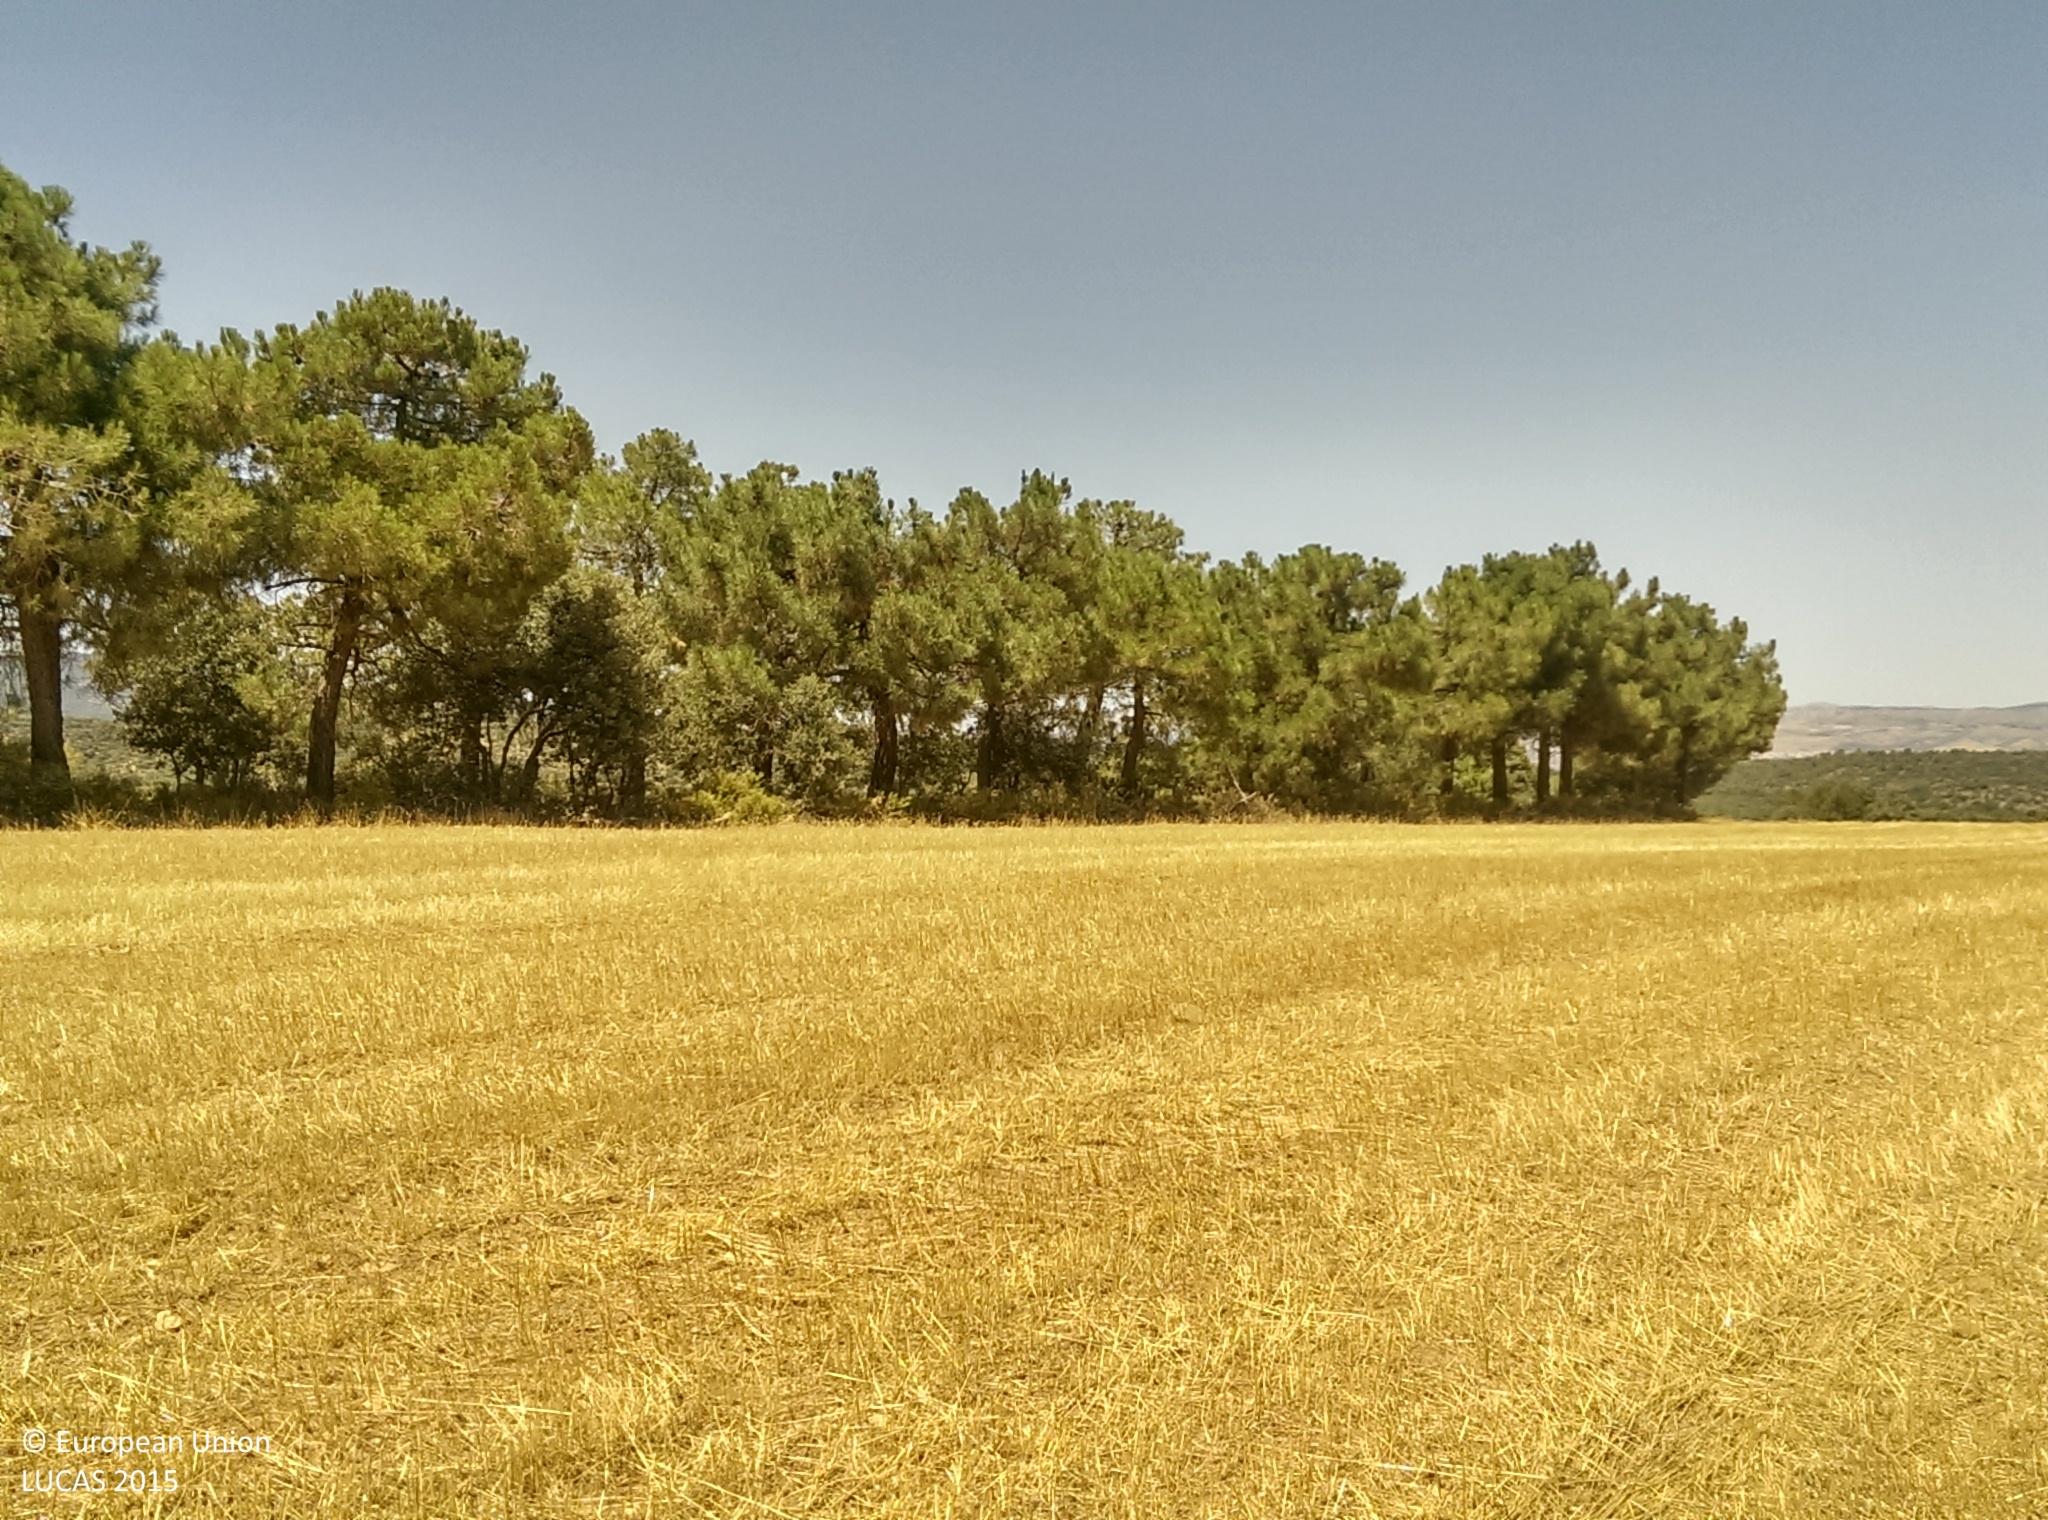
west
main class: Cropland
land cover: Oats
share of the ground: < 10 %
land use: Agriculture (excluding fallow land and kitchen gardens)
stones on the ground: 25 - 50 %
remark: Harvested field
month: July
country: ES
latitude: 37.2374
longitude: -3.2544
